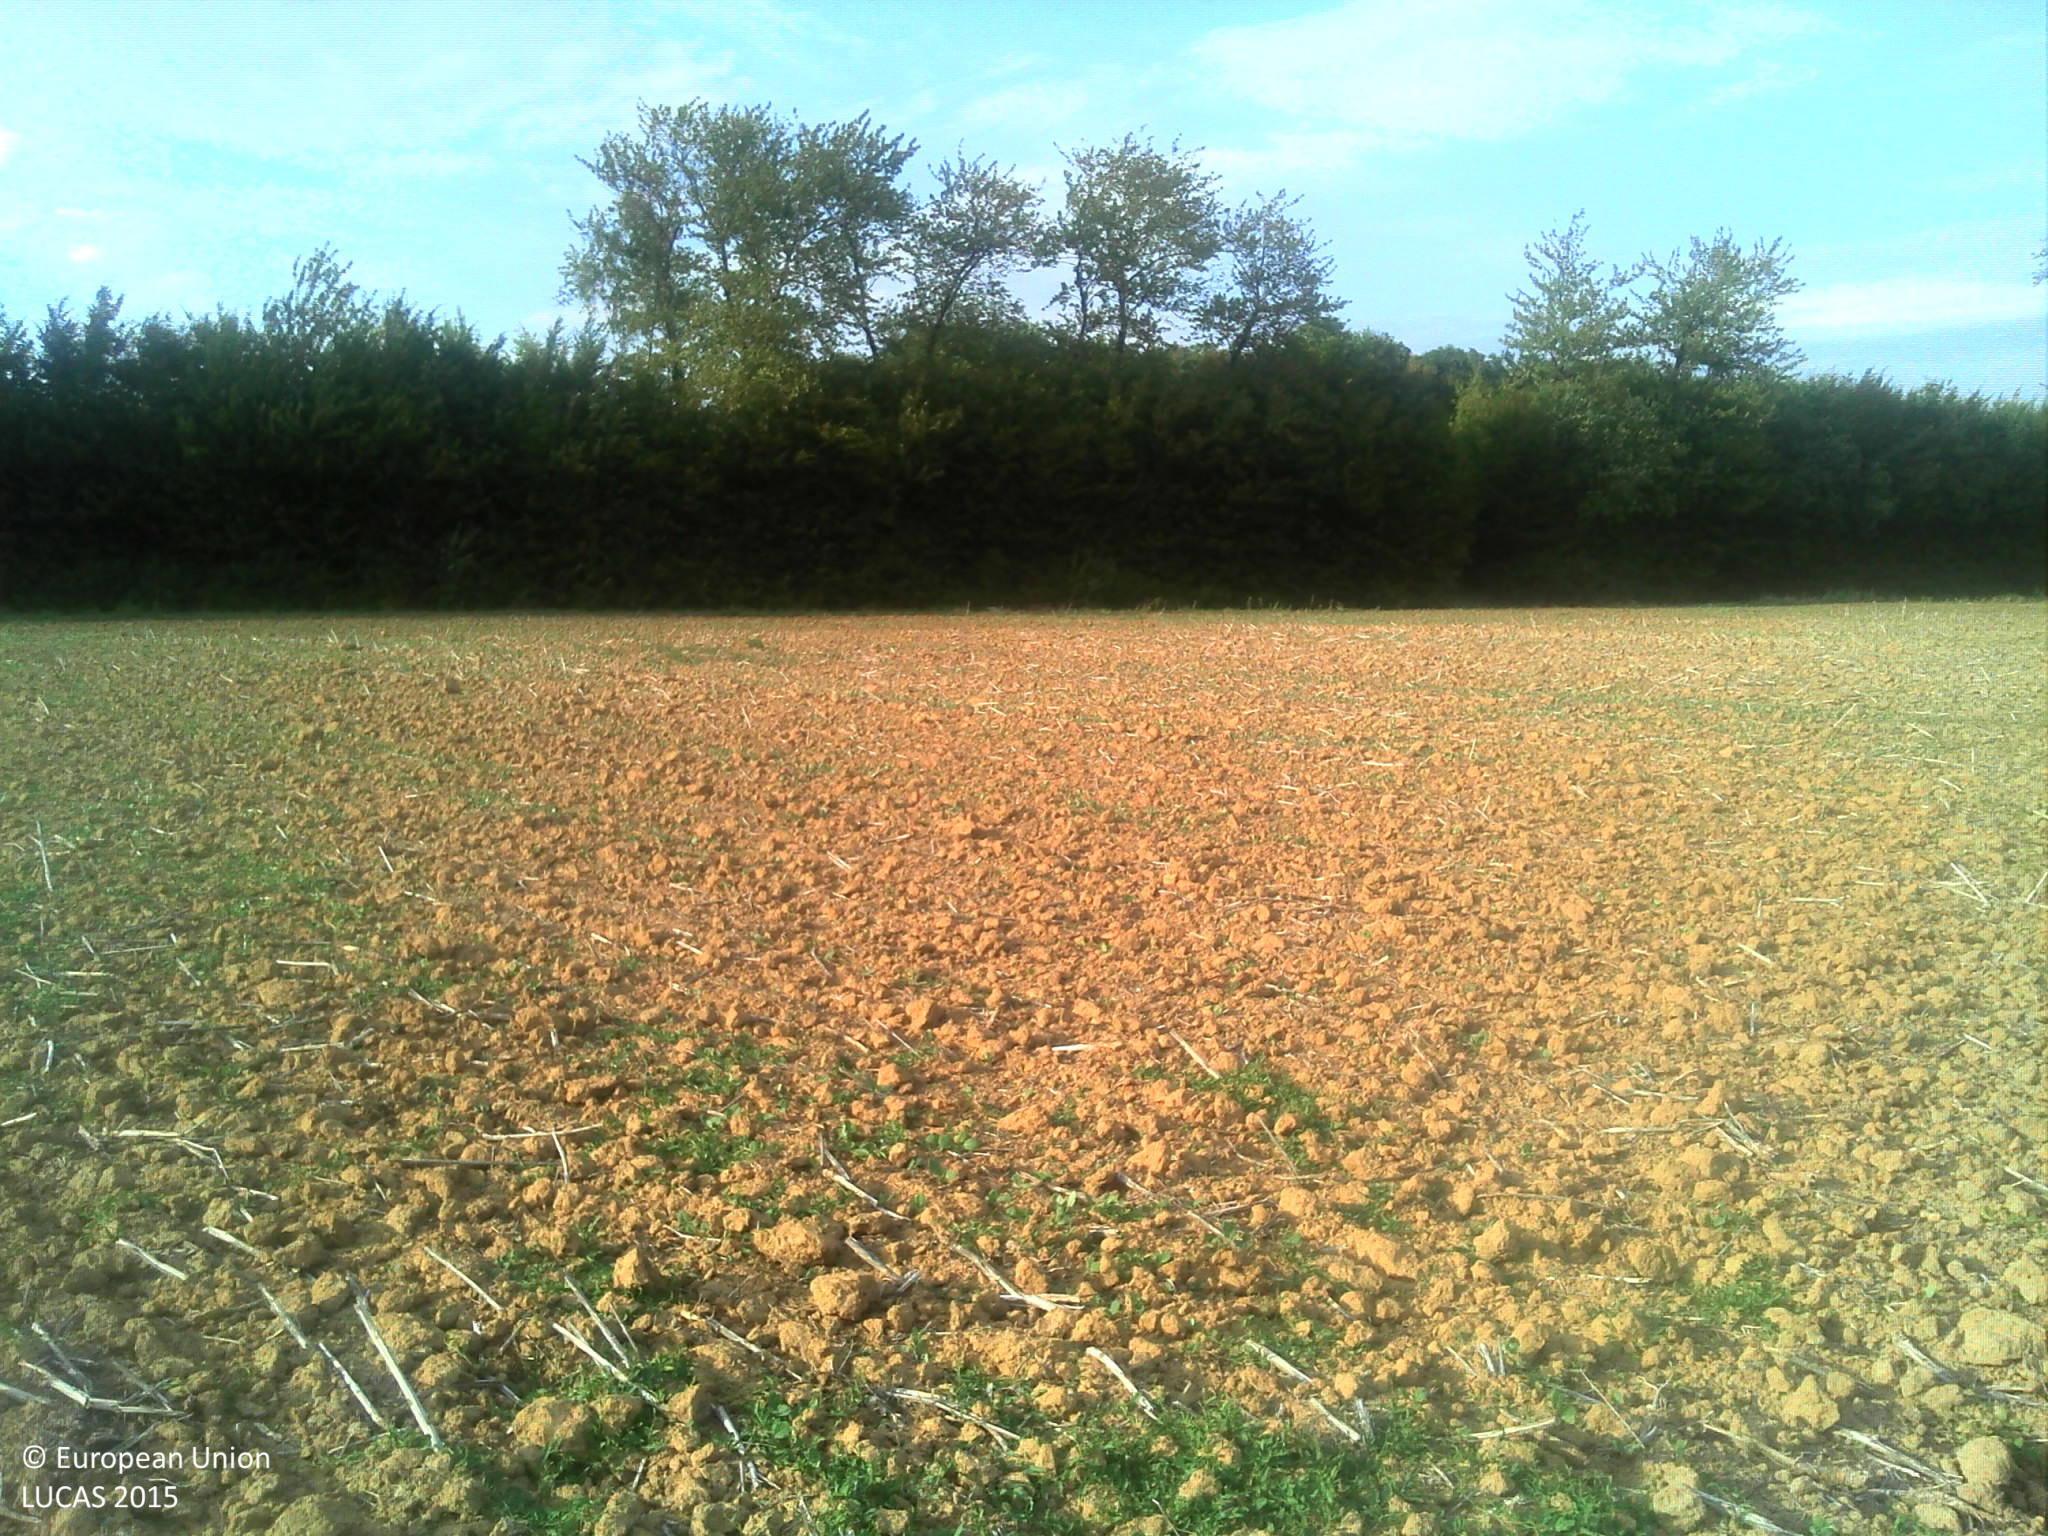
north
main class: Cropland
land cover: Rape and turnip rape
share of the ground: < 10 %
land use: Agriculture (excluding fallow land and kitchen gardens)
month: August
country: FR
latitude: 48.8765
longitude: 6.1411
